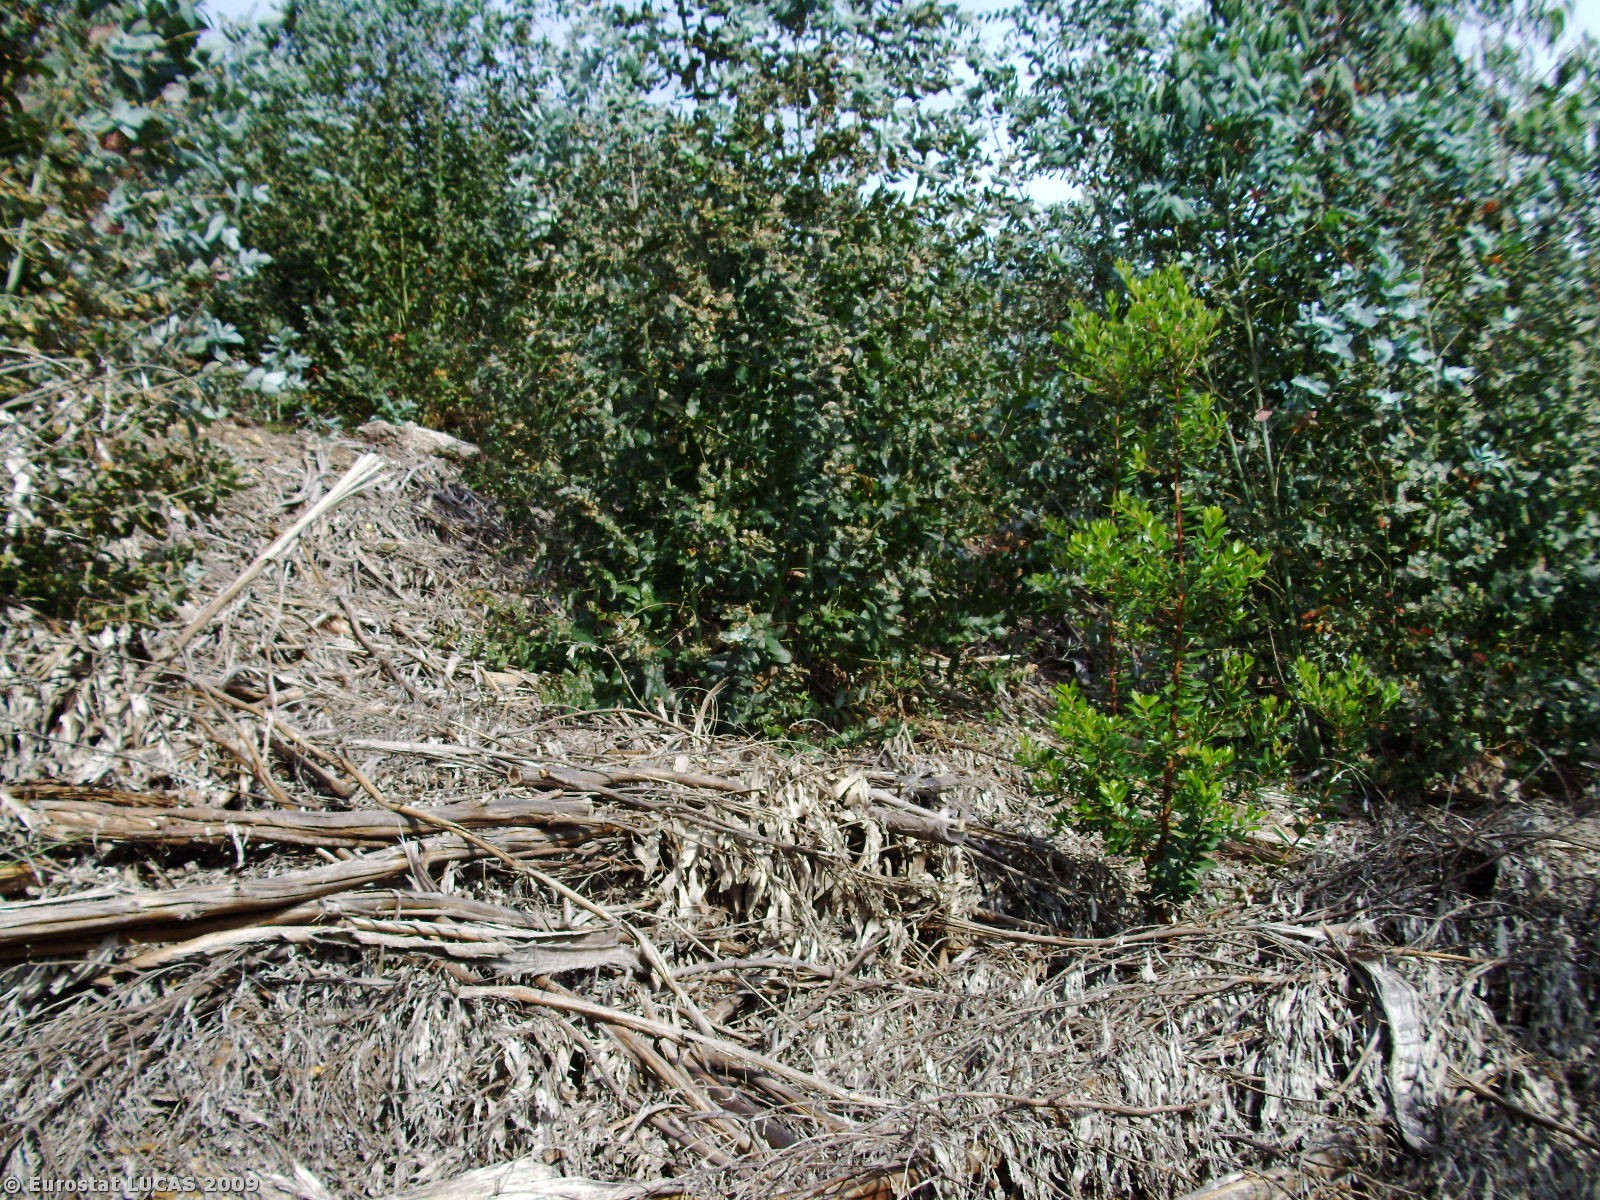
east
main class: Woodland
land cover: Broadleaved woodland
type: plantations and self-sown exotic forest
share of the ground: > 75 %
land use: Forestry
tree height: > 5 m
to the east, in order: Broadleaved woodland; Tracks; Broadleaved woodland; Tracks; Broadleaved woodland; Paved roads, cycling and walking lanes; Broadleaved woodland; Tracks; Broadleaved woodland
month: May
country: PT
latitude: 40.4609
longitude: -8.3531
